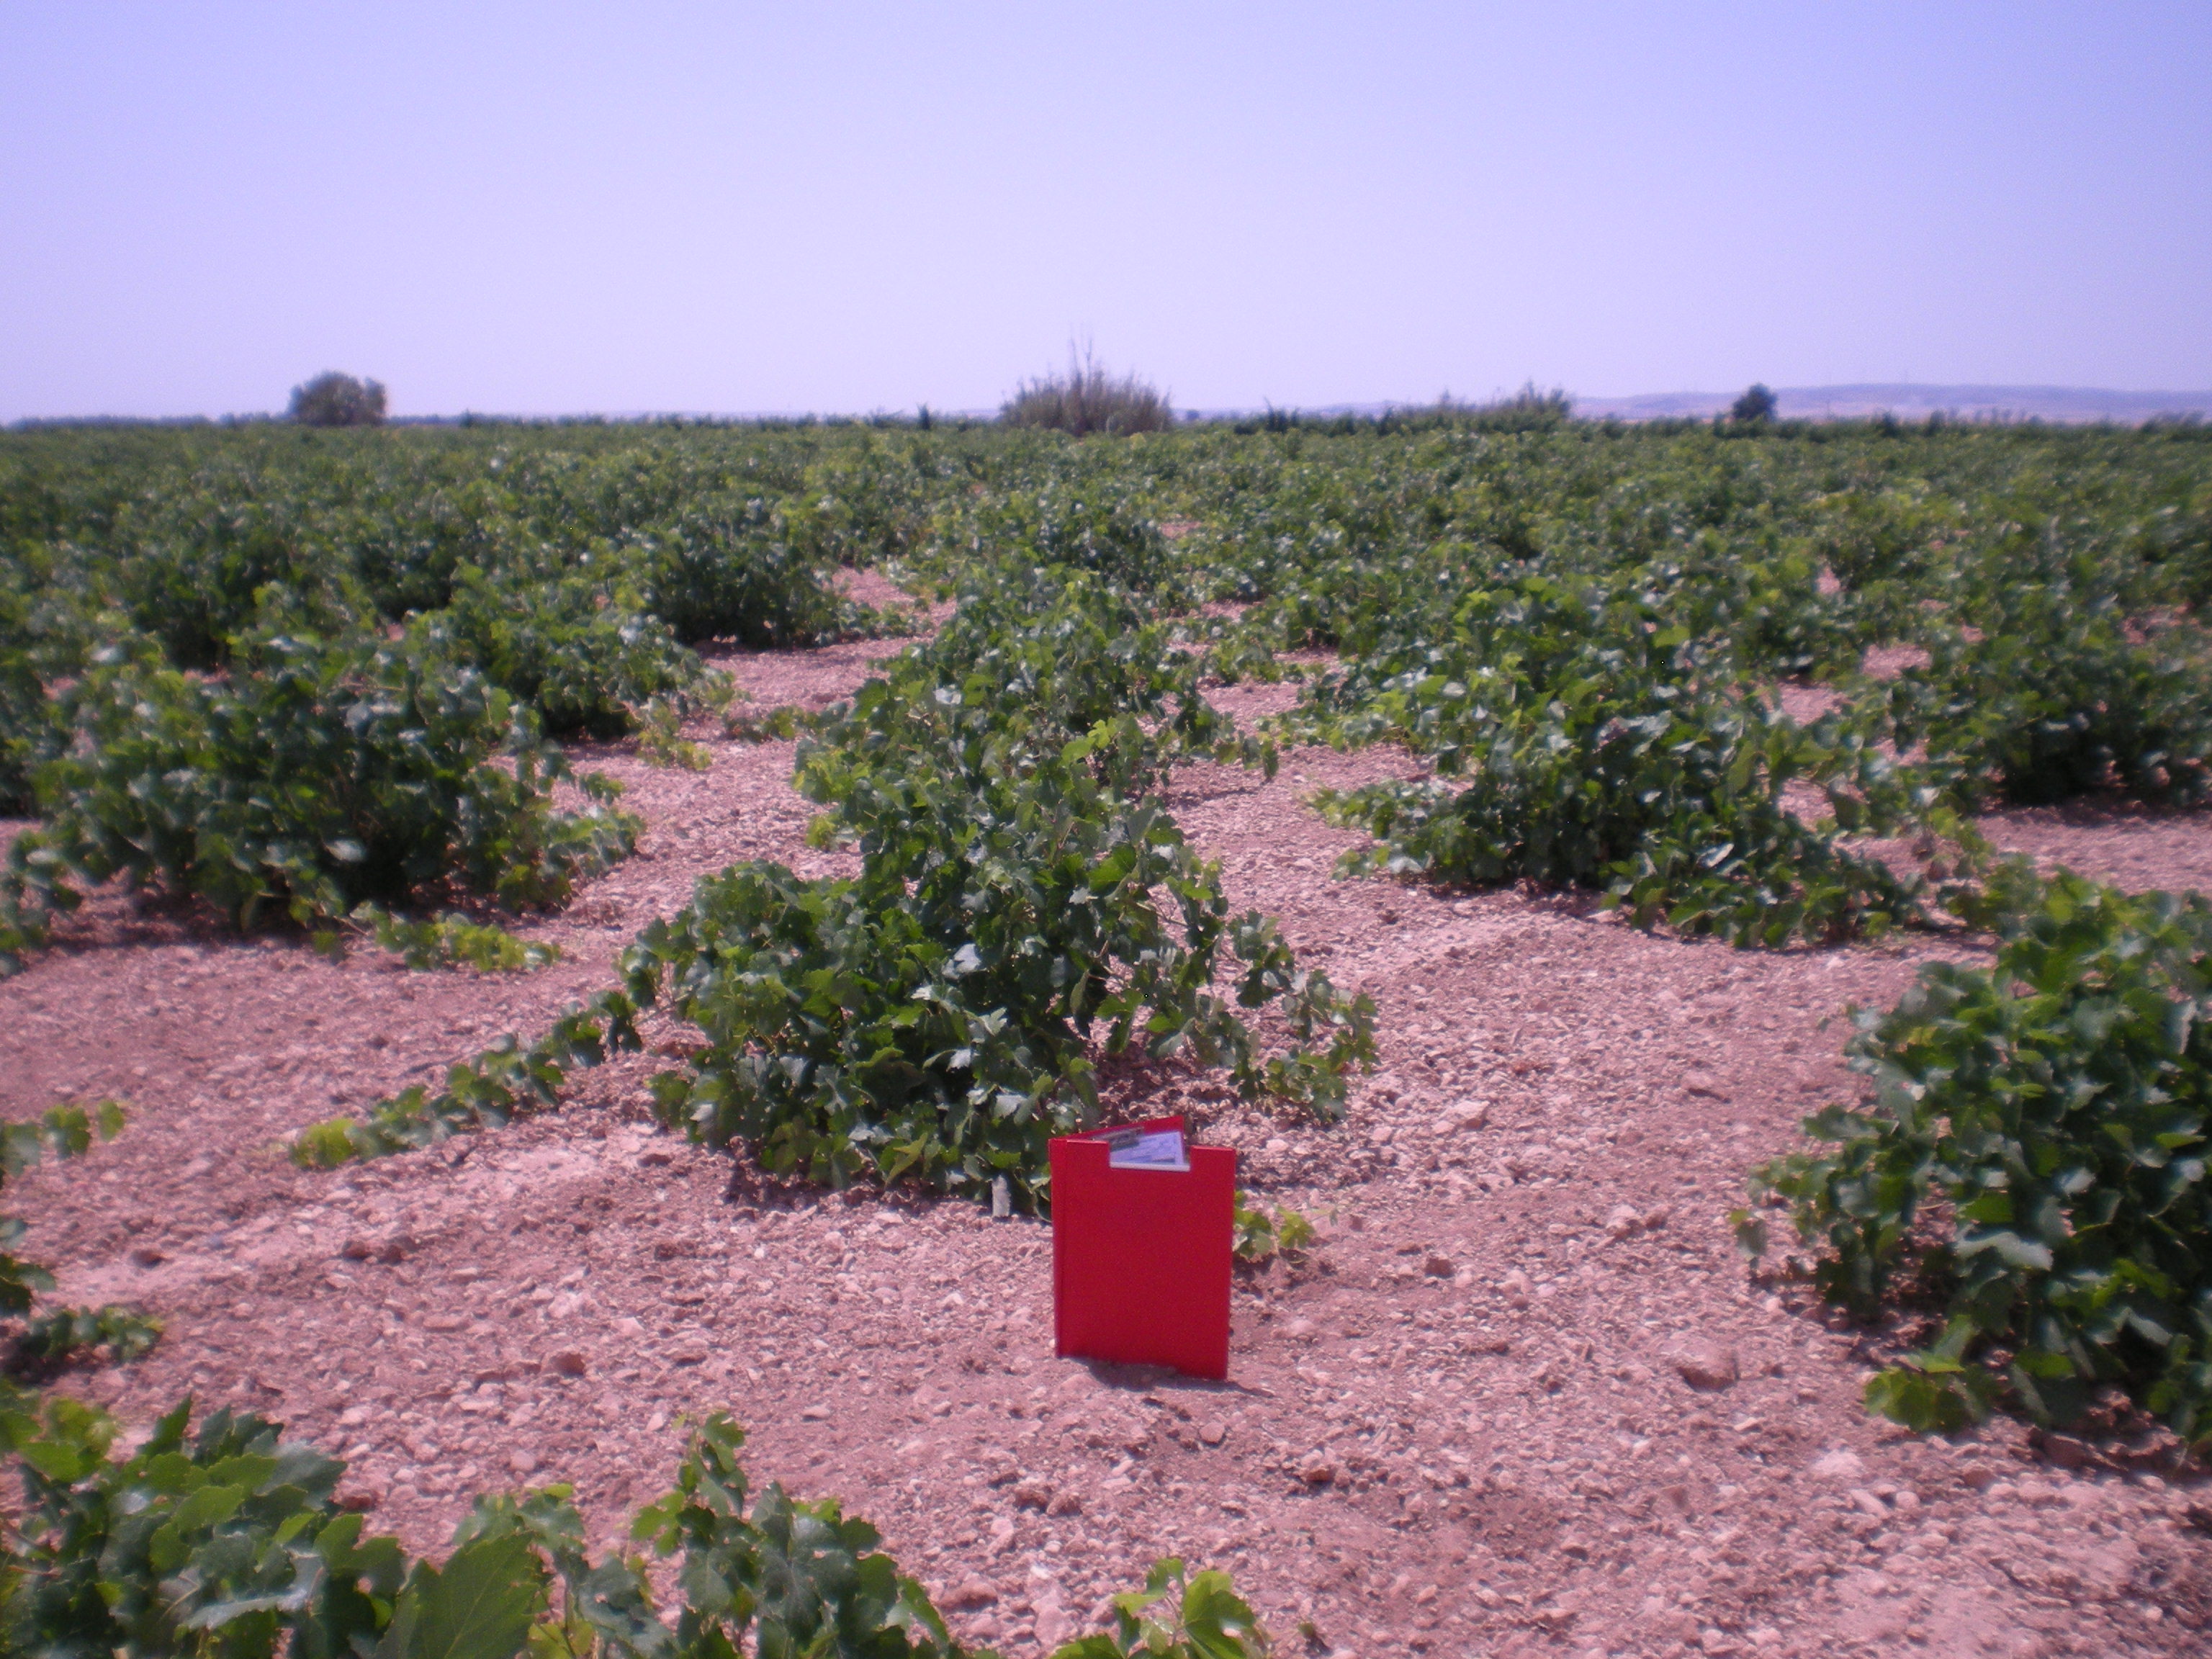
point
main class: Cropland
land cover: Vineyards
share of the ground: 25 - 50 %
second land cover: Other bare soil
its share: > 75 %
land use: Agriculture (excluding fallow land and kitchen gardens)
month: June
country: ES
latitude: 39.6394
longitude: -3.2469
